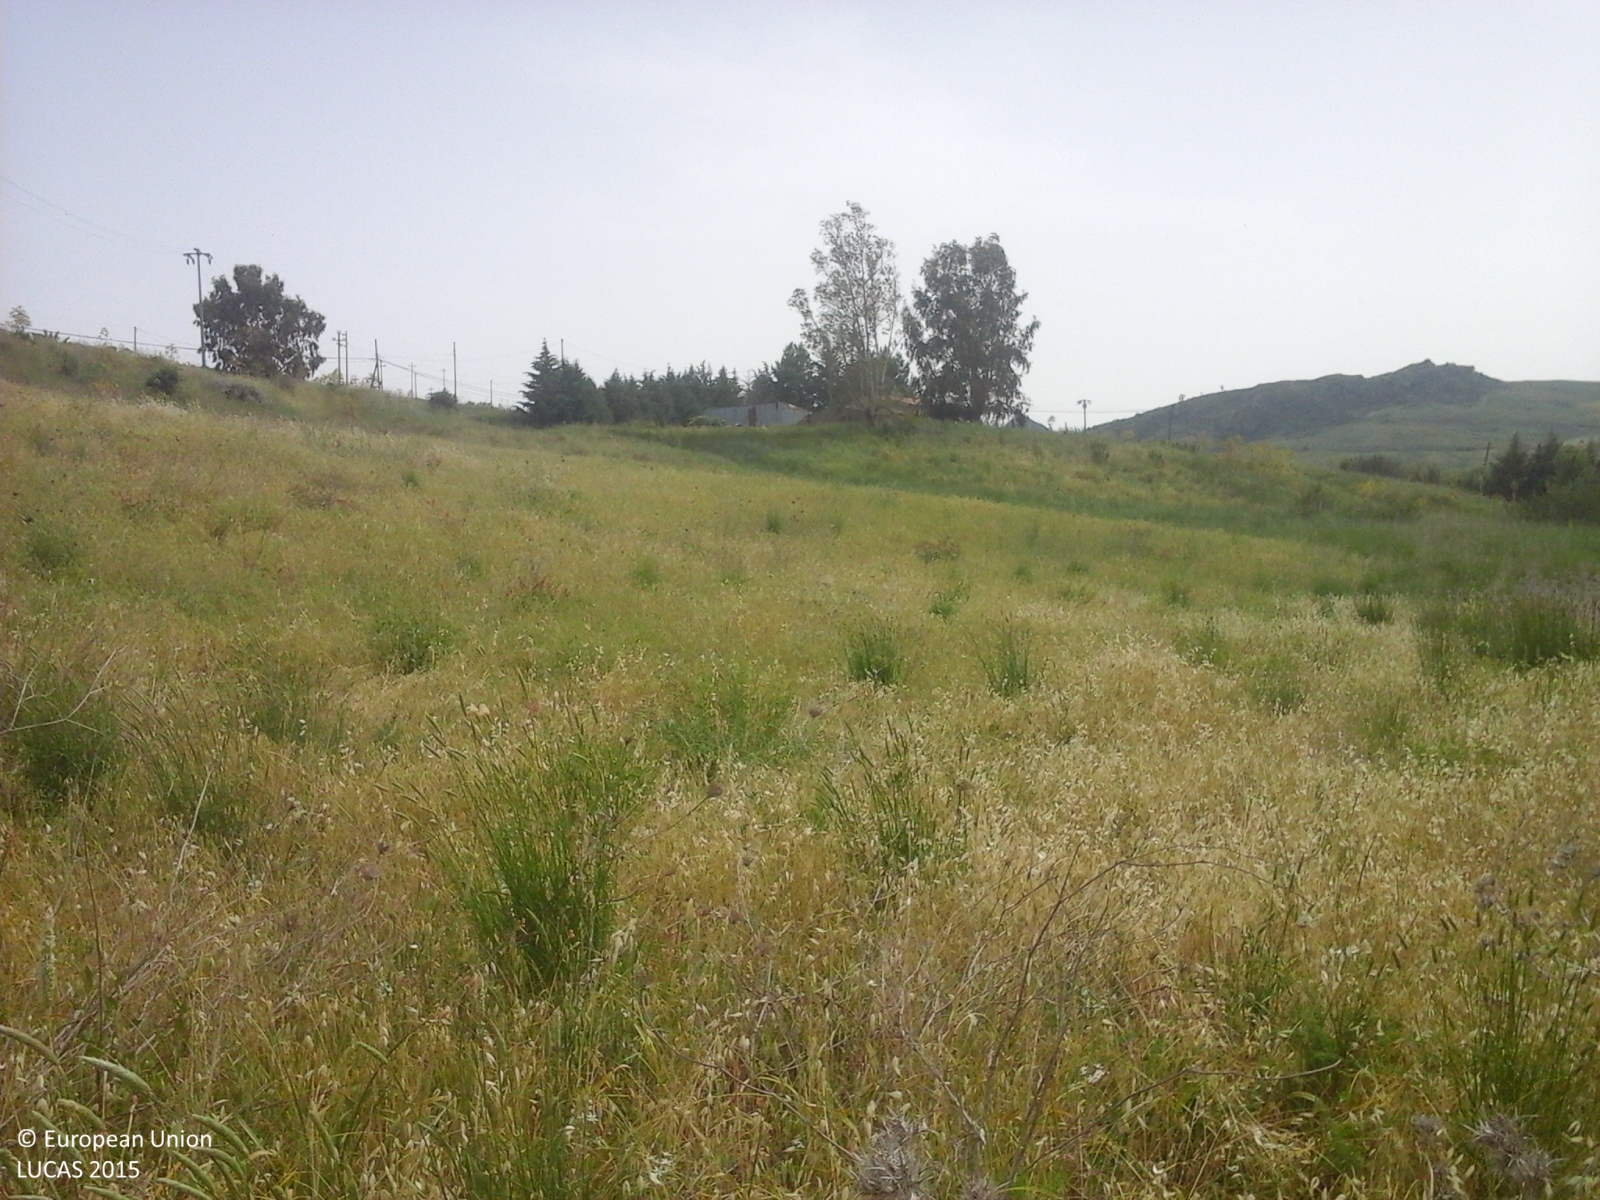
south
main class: Grassland
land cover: Spontaneously vegetated surfaces
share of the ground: > 75 %
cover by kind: herbaceous plants 100 %
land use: Fallow land
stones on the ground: < 10 %
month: May
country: IT
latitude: 37.7455
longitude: 14.2030
